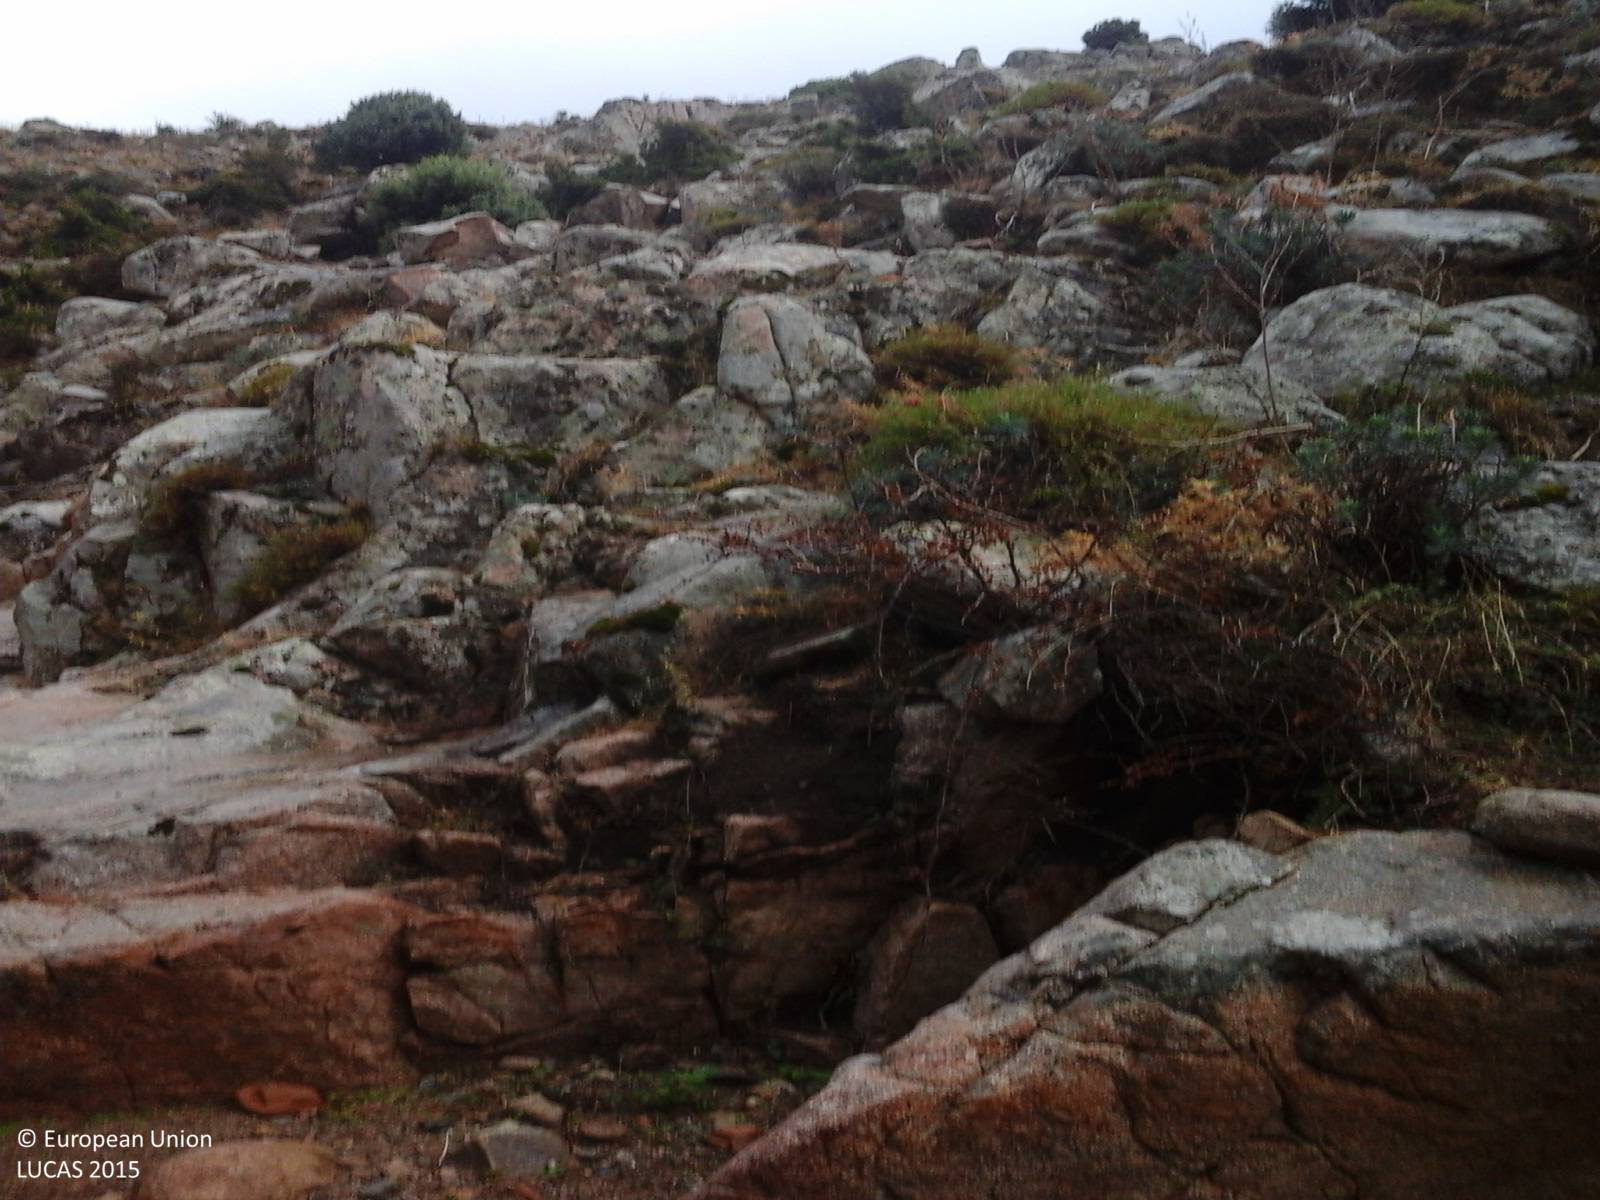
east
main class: Shrubland
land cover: Shrubland without tree cover
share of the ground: > 75 %
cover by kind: consolidated bare surface 40 %, shrubs 25 %, unconsolidated bare surface 20 %, herbaceous plants 15 %
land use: Semi-natural and natural areas not in use
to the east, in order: Shrubland without tree cover; Rocks and stones; Shrubland without tree cover; Rocks and stones
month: September
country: IT
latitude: 39.9392
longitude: 9.3366
